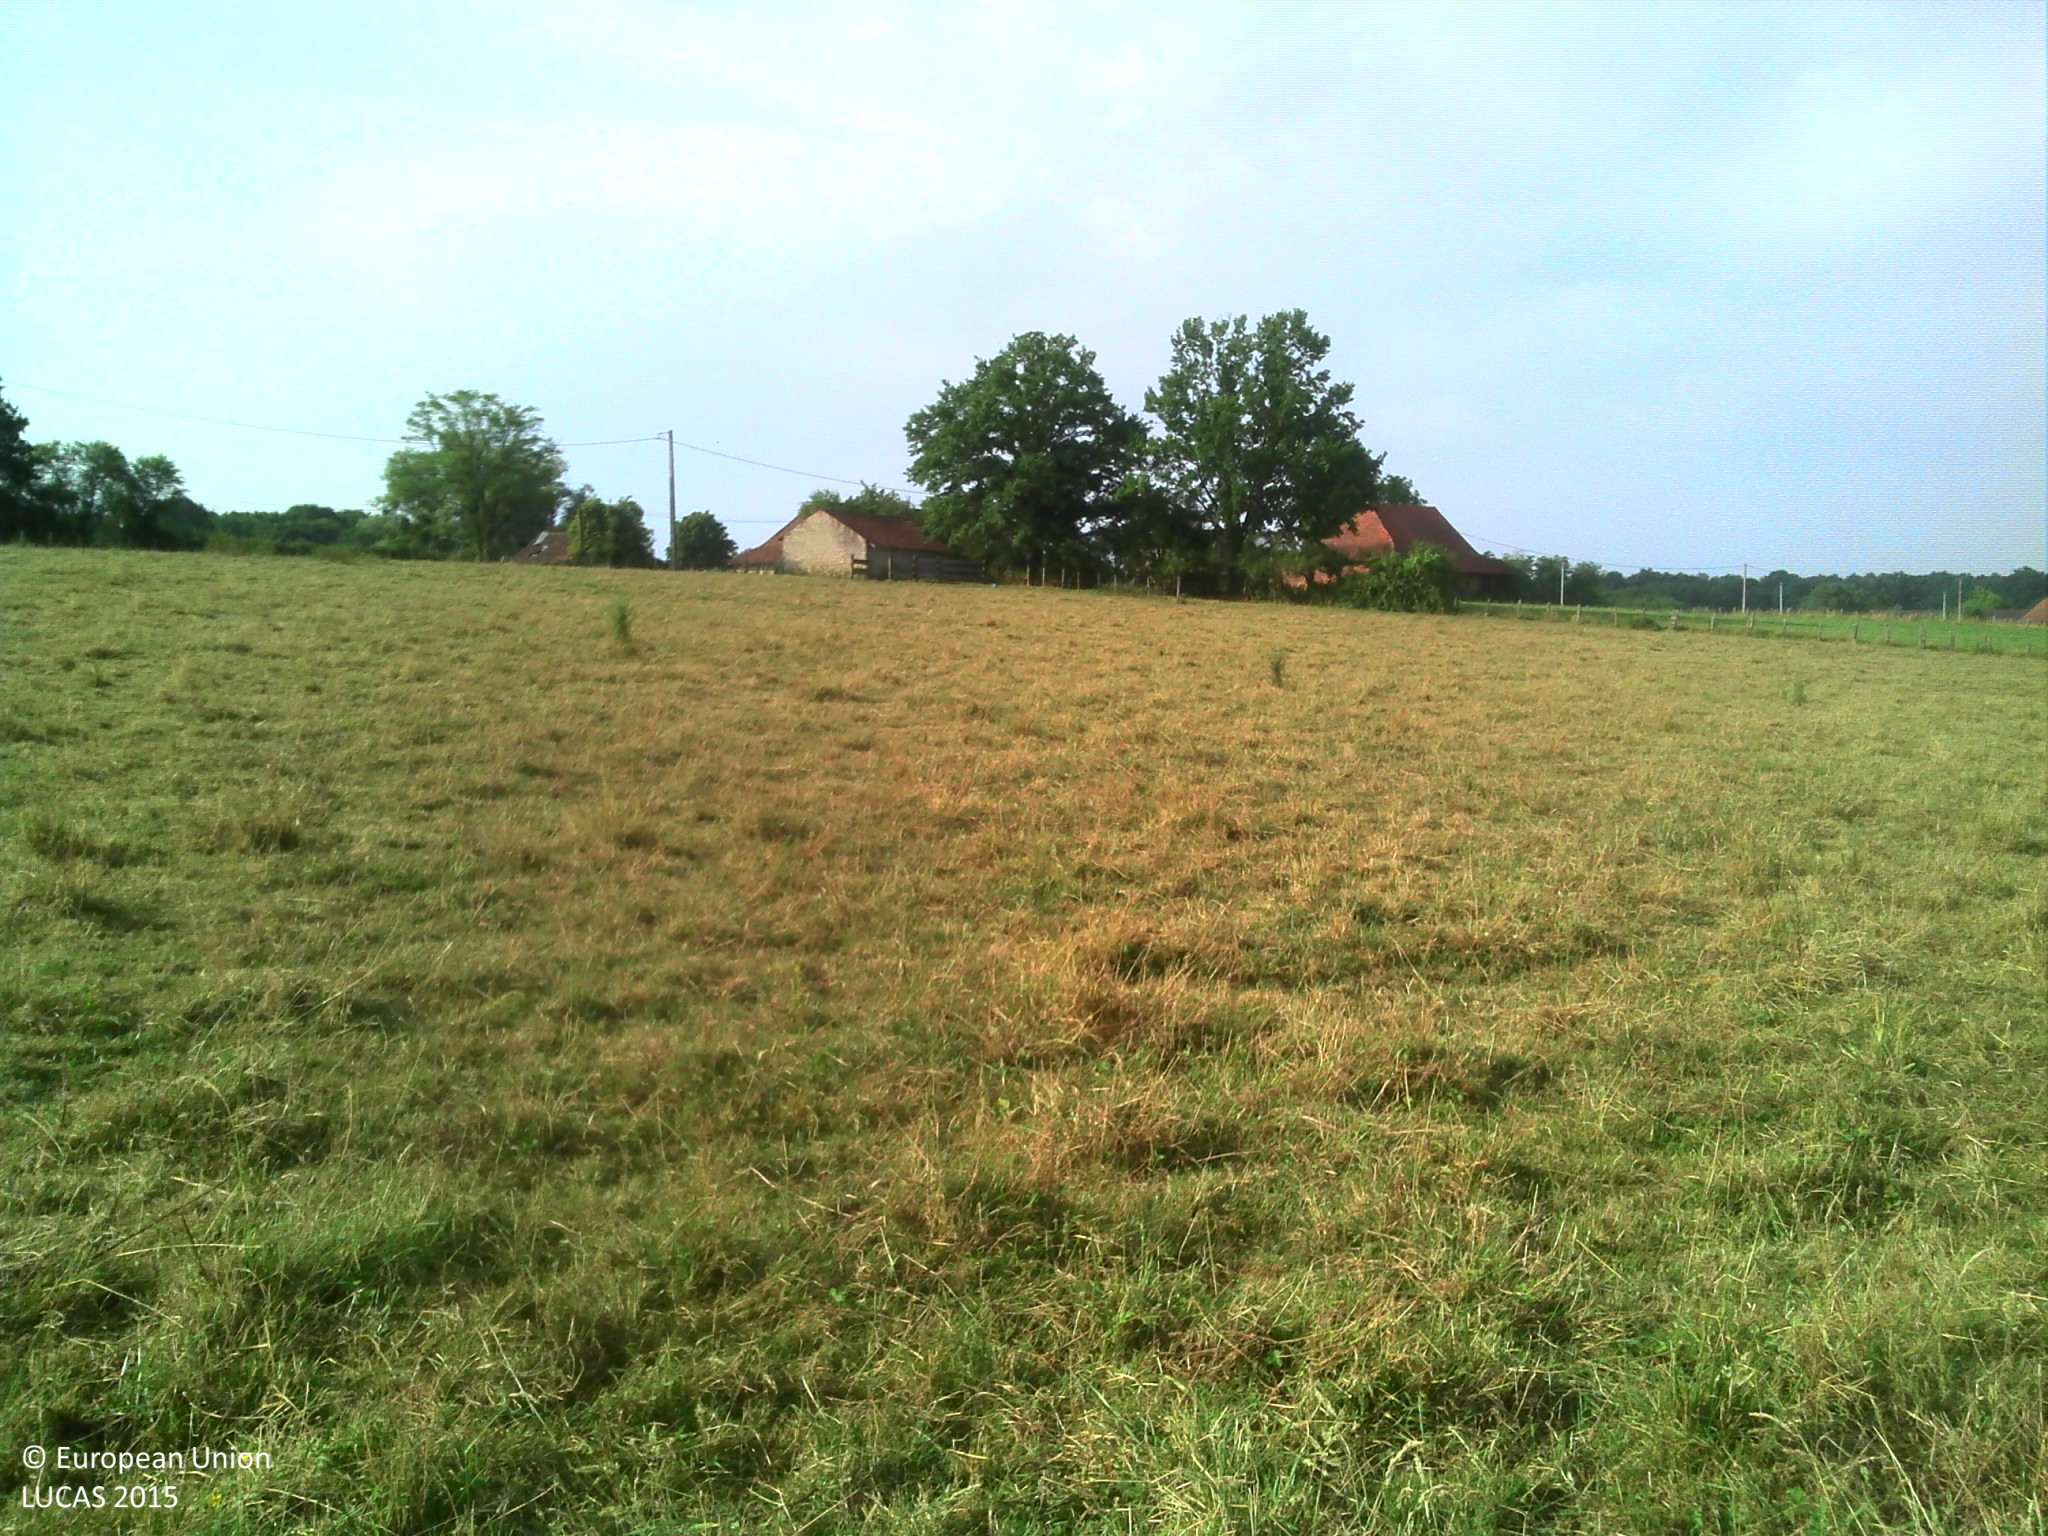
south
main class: Grassland
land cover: Grassland without tree/shrub cover
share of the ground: > 75 %
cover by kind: herbaceous plants 100 %
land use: Agriculture (excluding fallow land and kitchen gardens)
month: July
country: FR
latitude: 46.8475
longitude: 5.3989
